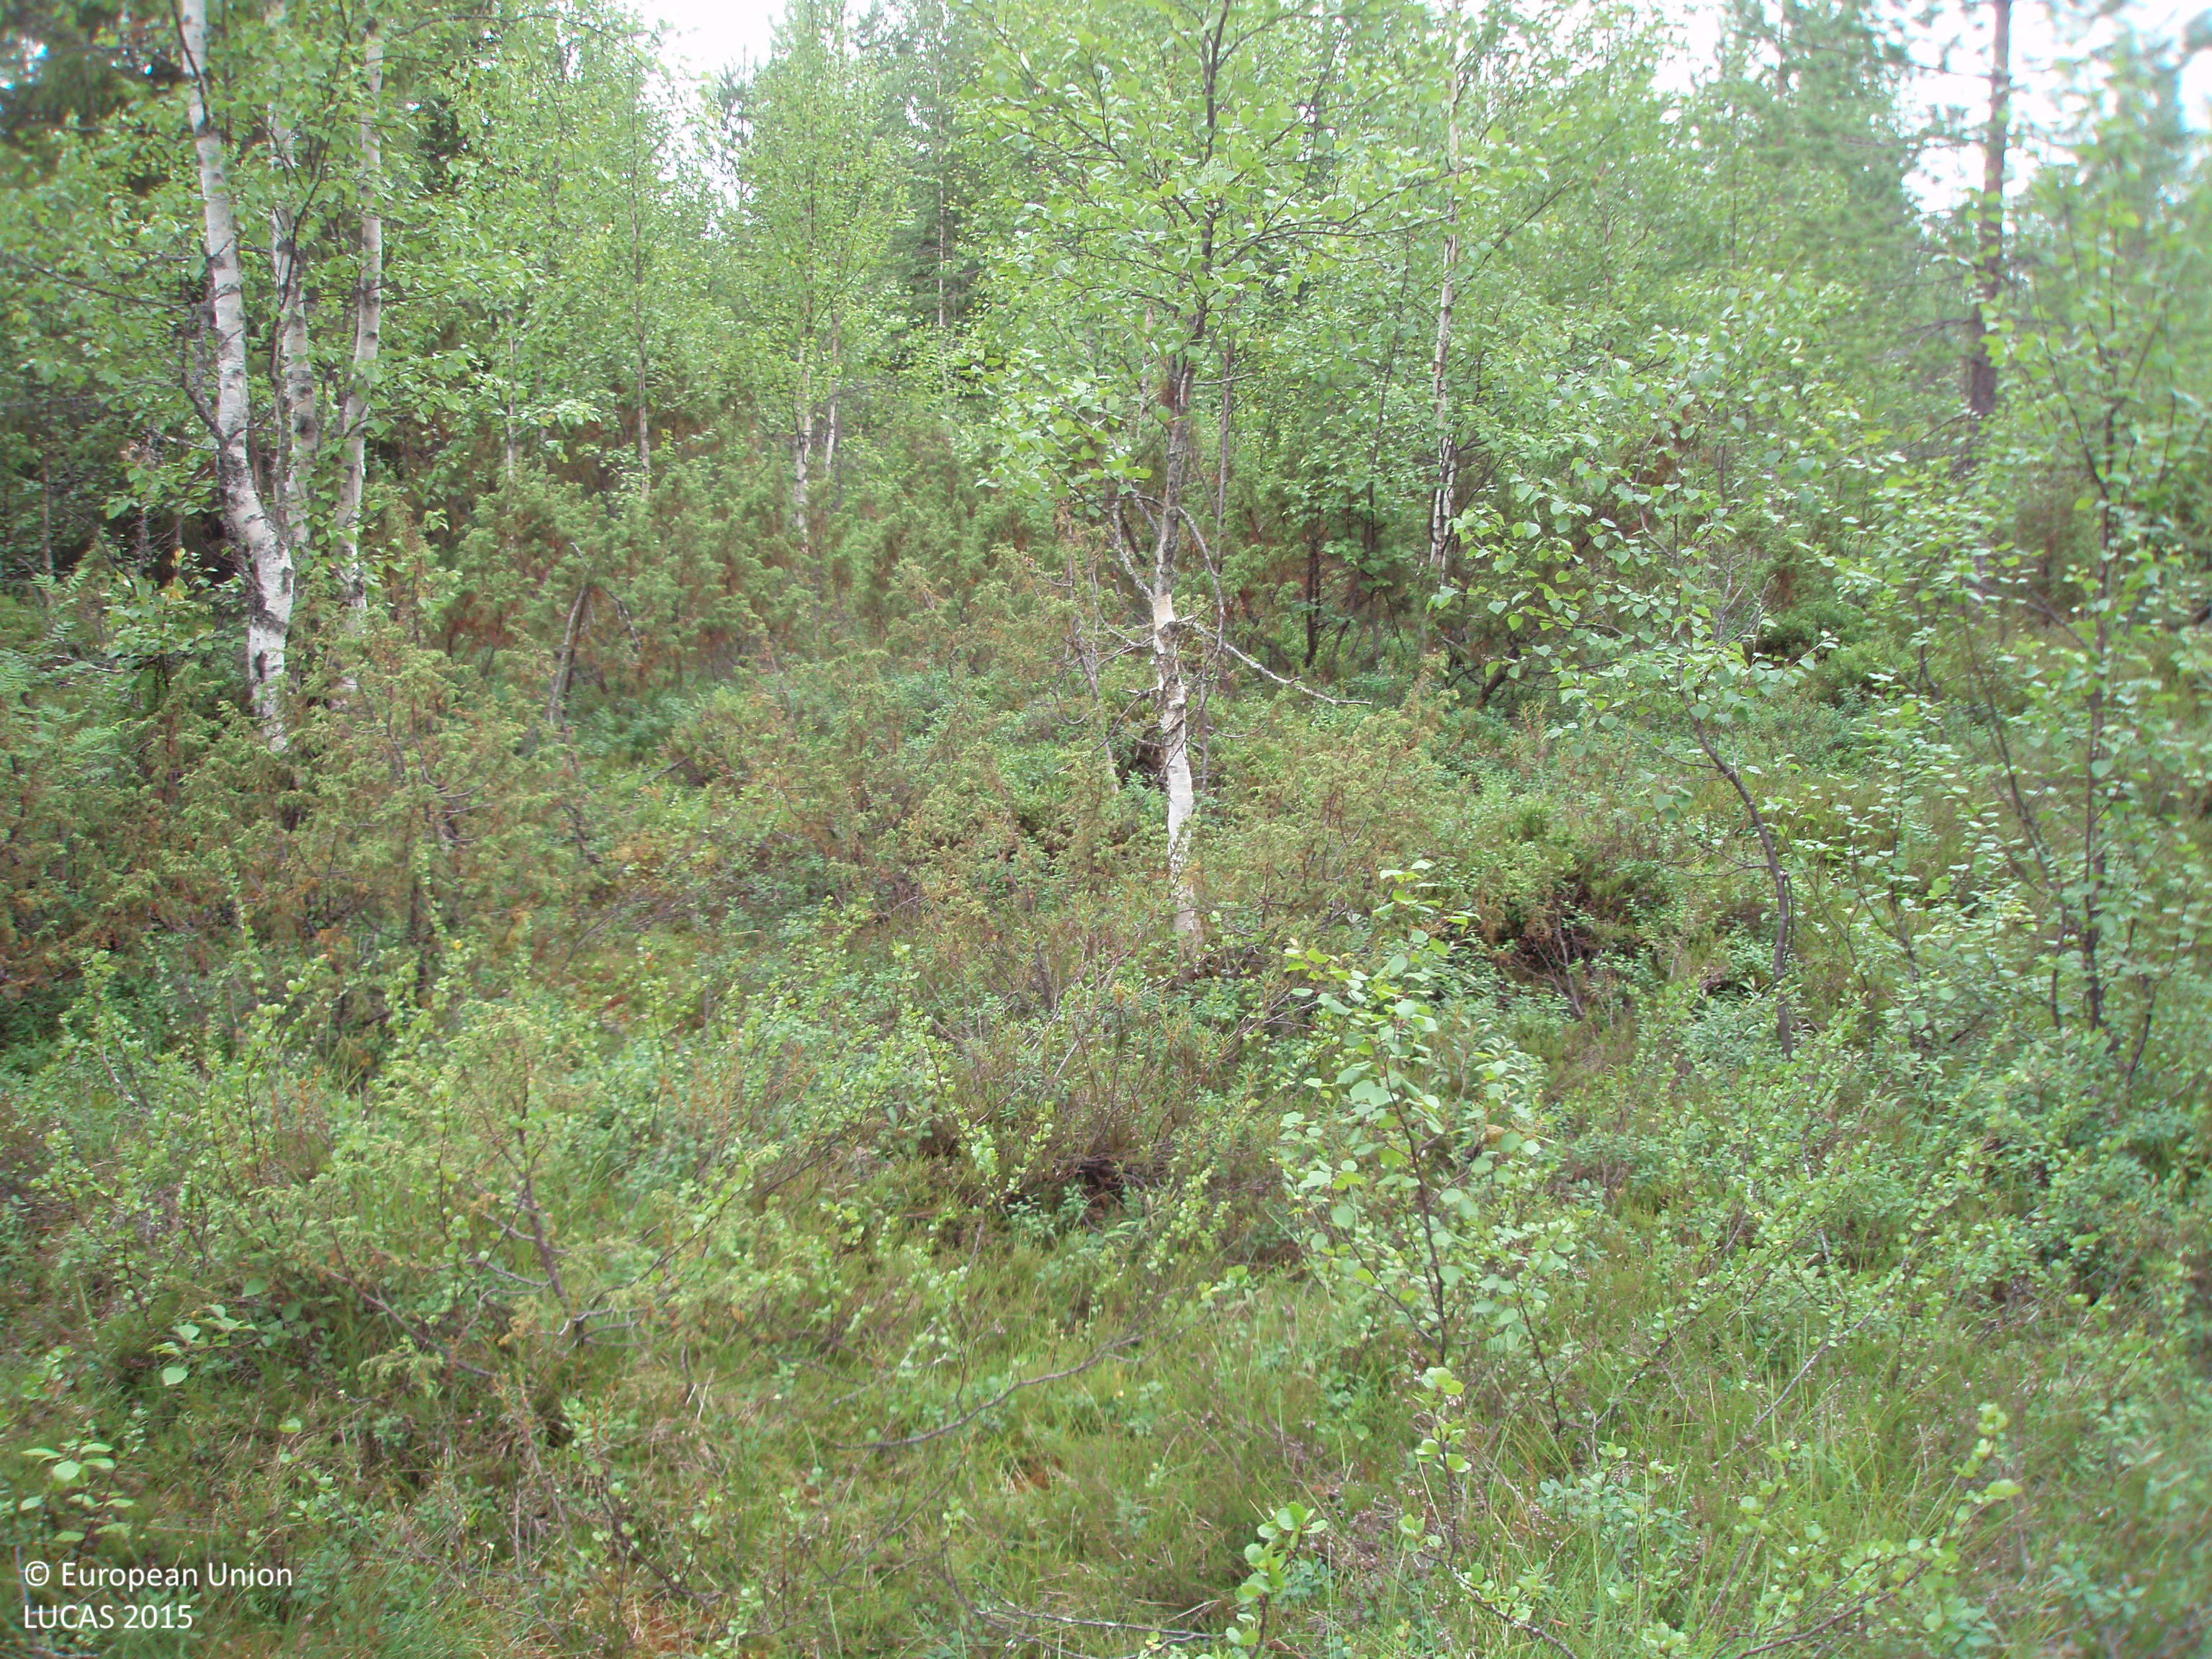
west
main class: Woodland
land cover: Other mixed woodland
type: boreal forest
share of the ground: 25 - 50 %
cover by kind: shrubs 40 %, coniferous forest trees 25 %, broadleaved forest trees 20 %, herbaceous plants 10 %, lichens and mosses 5 %
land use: Forestry
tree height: > 5 m
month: July
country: FI
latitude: 65.6219
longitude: 27.7438
